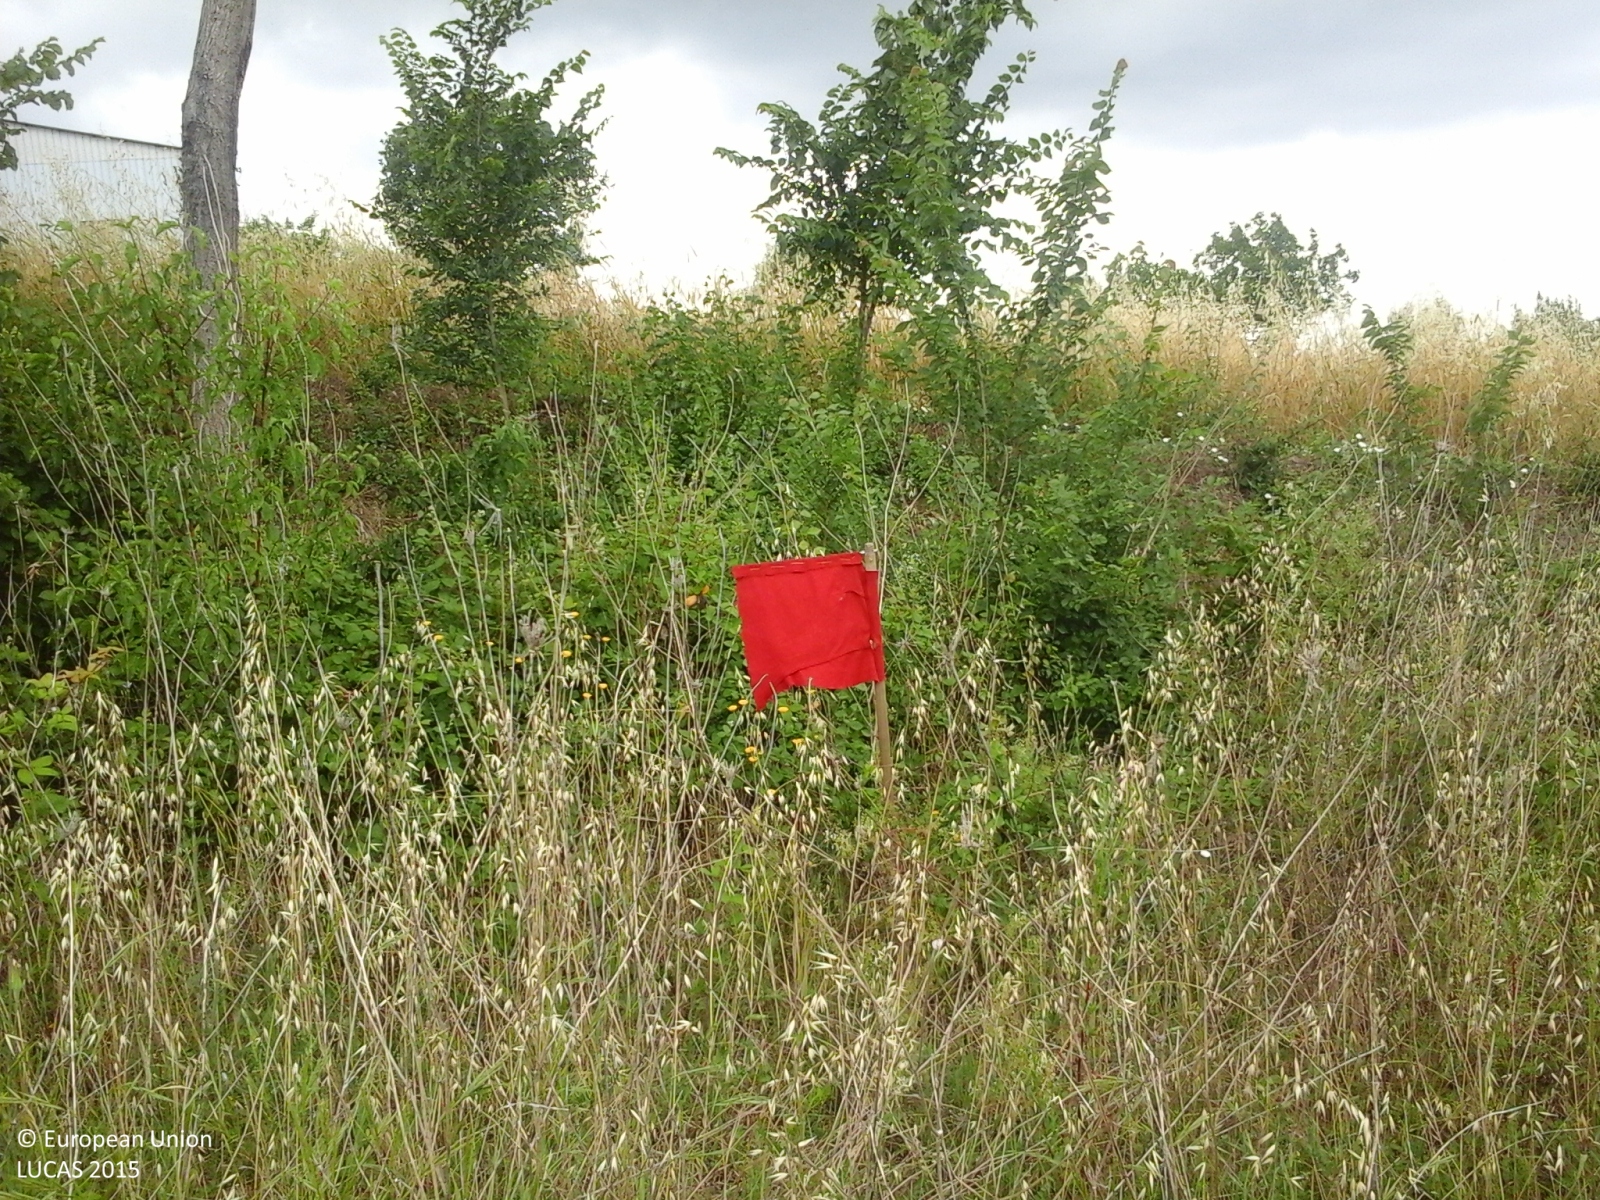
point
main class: Shrubland
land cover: Shrubland without tree cover
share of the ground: 50 - 75 %
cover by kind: shrubs 60 %, herbaceous plants 40 %
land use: Fallow land
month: June
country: IT
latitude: 41.0237
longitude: 15.0828
